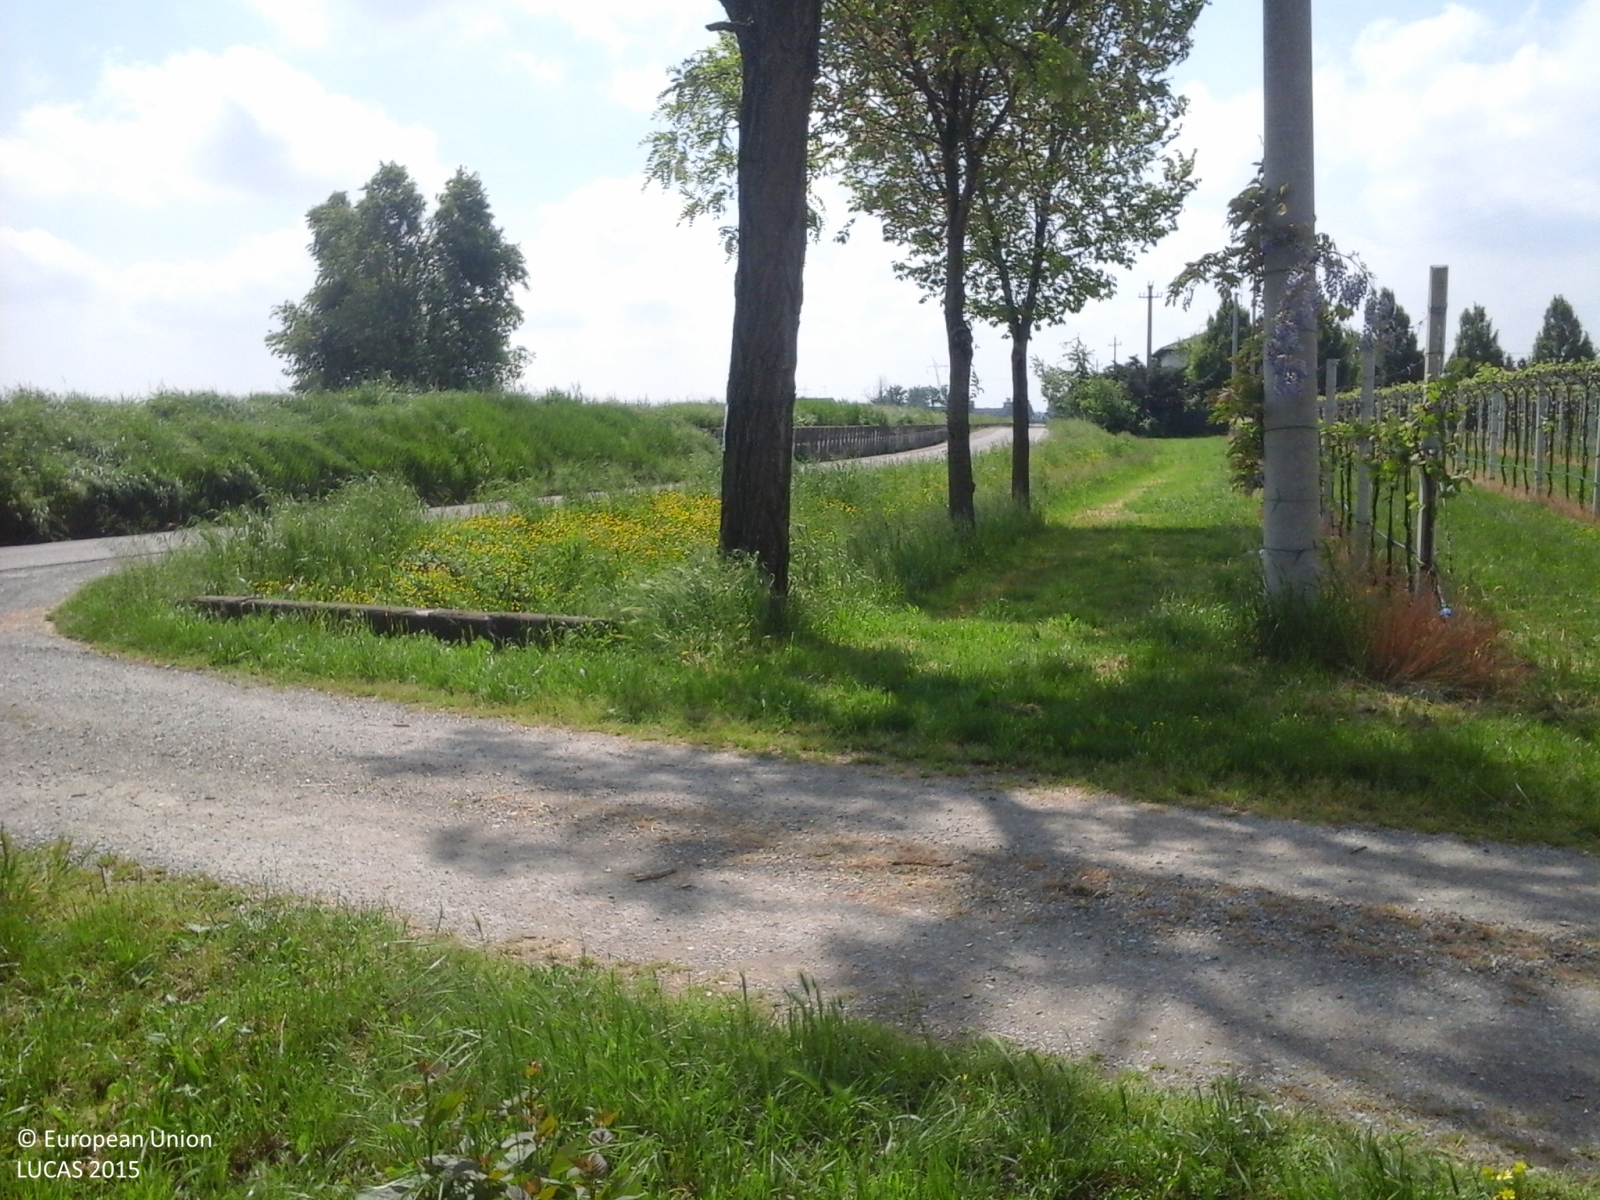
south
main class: Cropland
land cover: Cherry fruit
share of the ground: > 75 %
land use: Kitchen garden
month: April
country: IT
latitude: 44.8162
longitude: 10.8203
